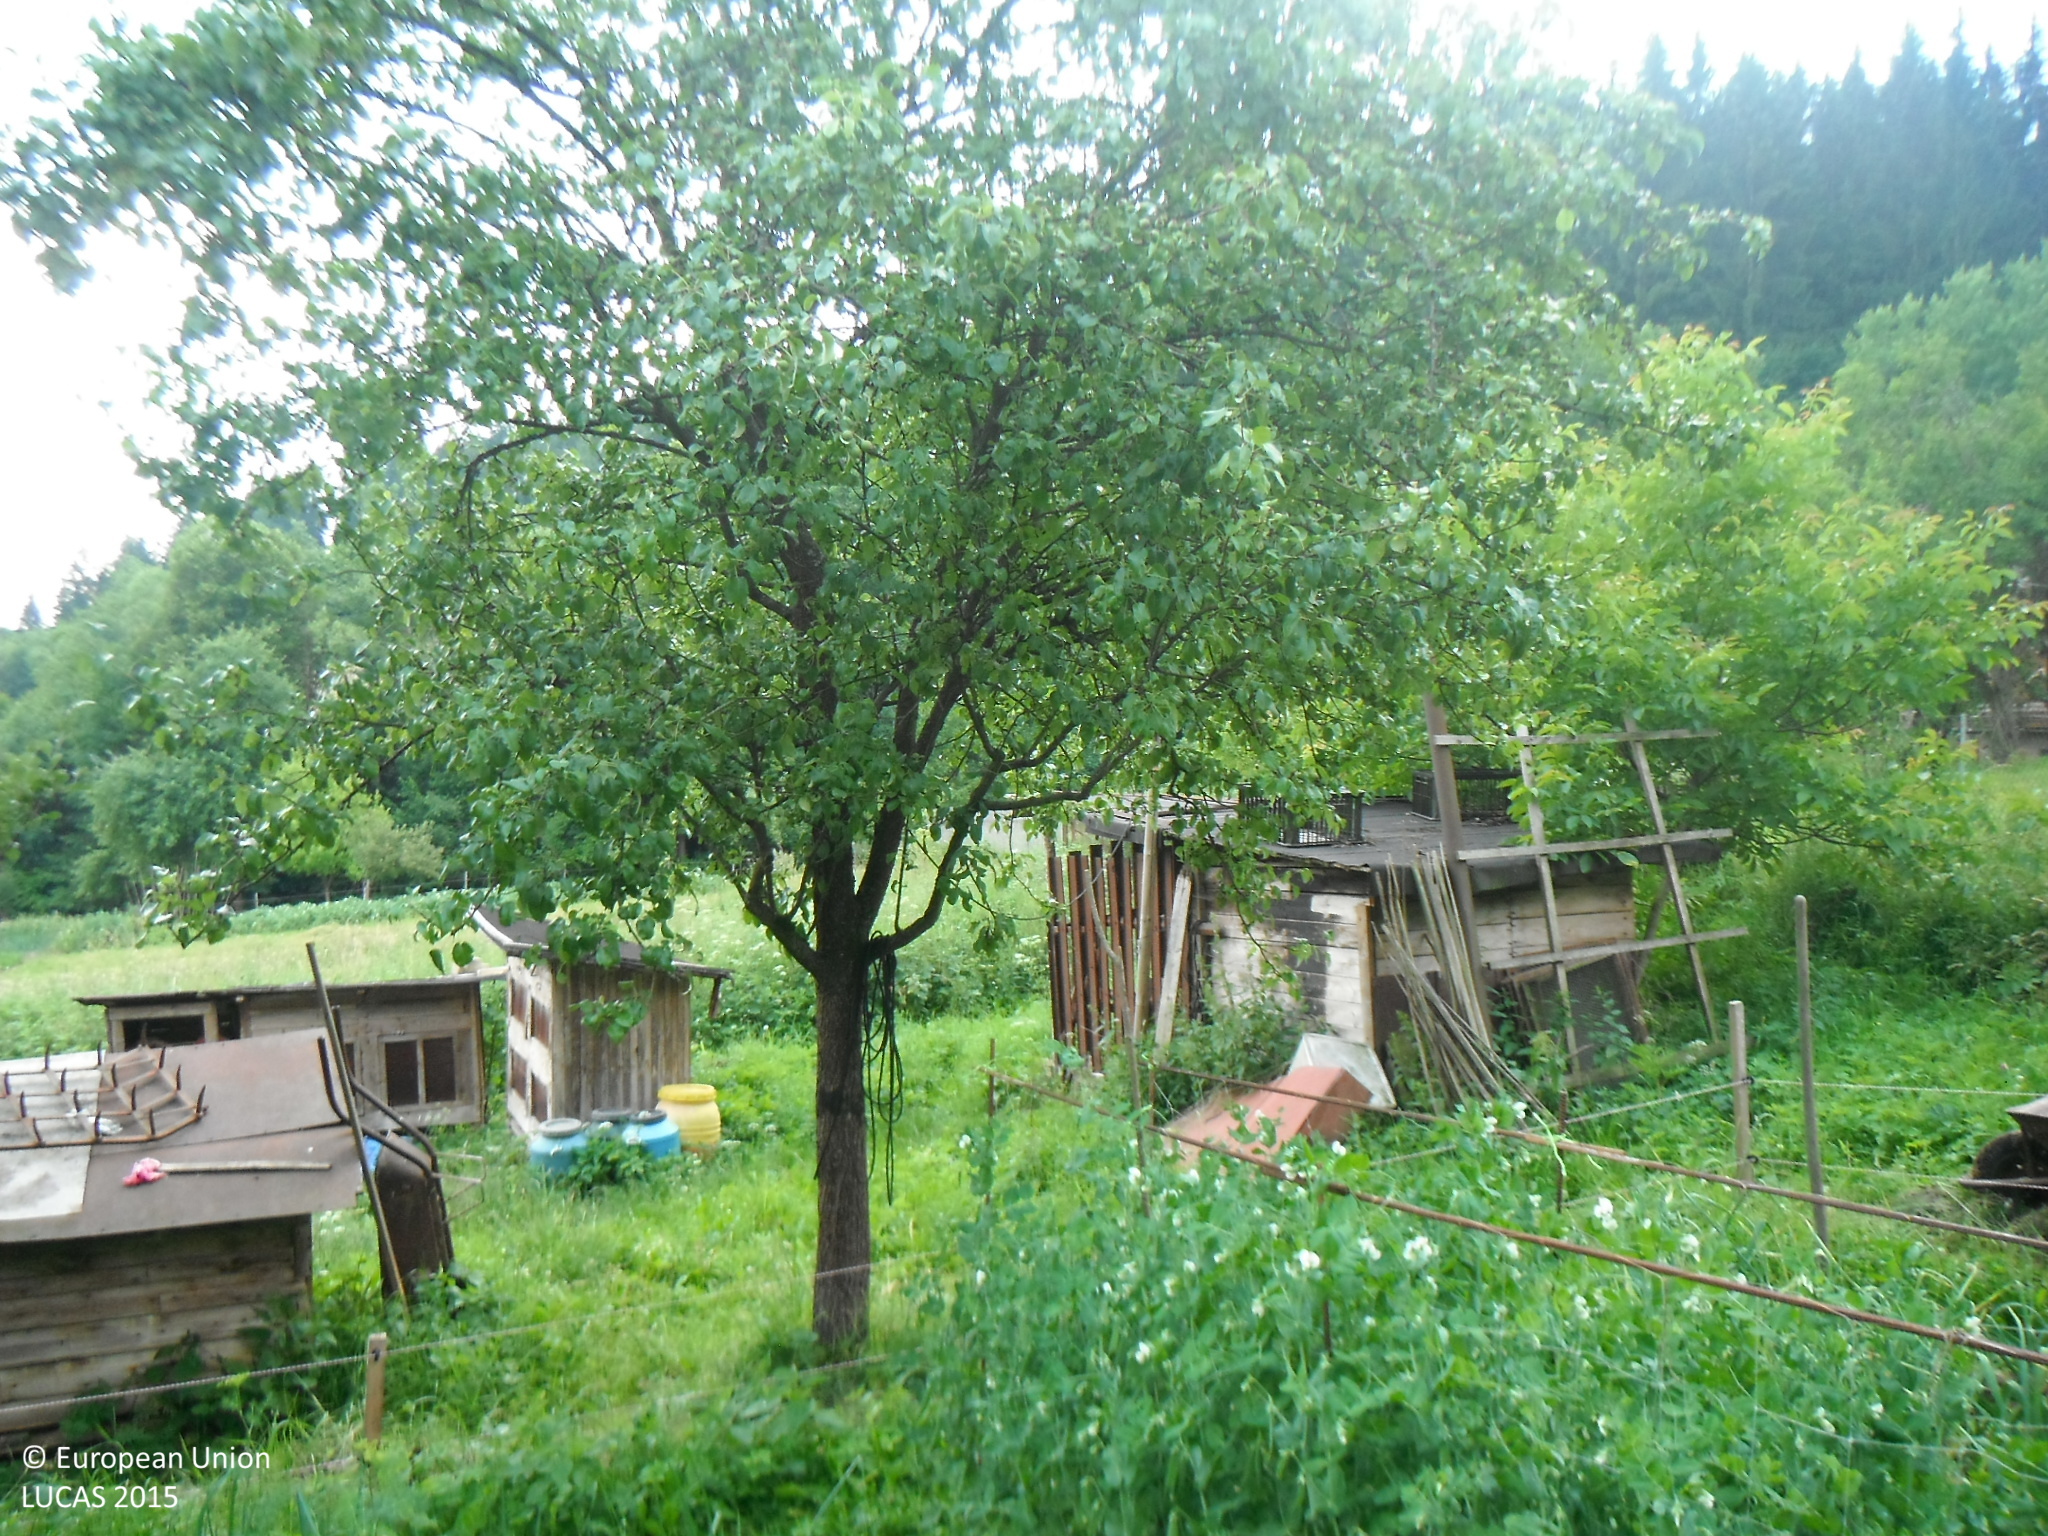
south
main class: Cropland
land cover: Apple fruit
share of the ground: 25 - 50 %
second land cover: Grassland without tree/shrub cover
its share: > 75 %
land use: Kitchen garden
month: July
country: SK
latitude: 49.2814
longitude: 18.5830
